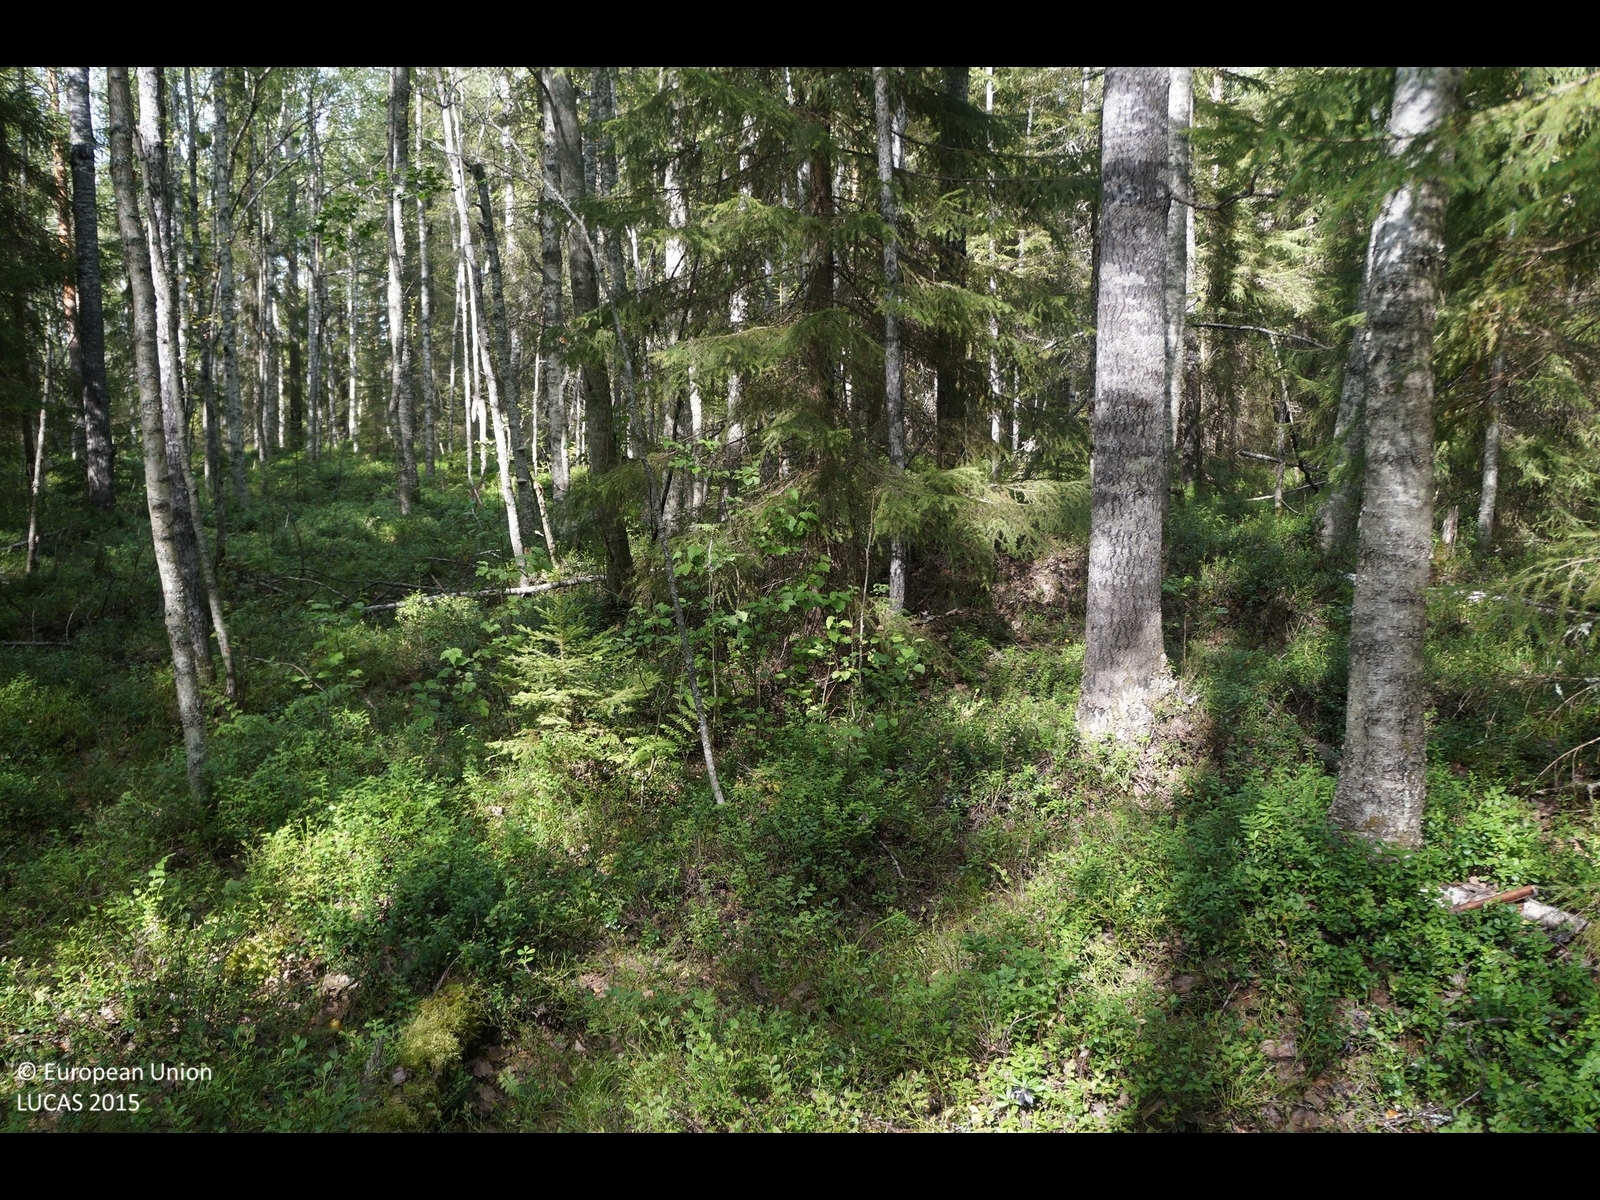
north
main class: Woodland
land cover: Spruce dominated mixed woodland
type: boreal forest
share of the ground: 50 - 75 %
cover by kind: coniferous forest trees 40 %, broadleaved forest trees 30 %, shrubs 25 %, lichens and mosses 5 %
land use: Forestry
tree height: > 5 m
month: August
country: FI
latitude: 64.5885
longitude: 24.7560
